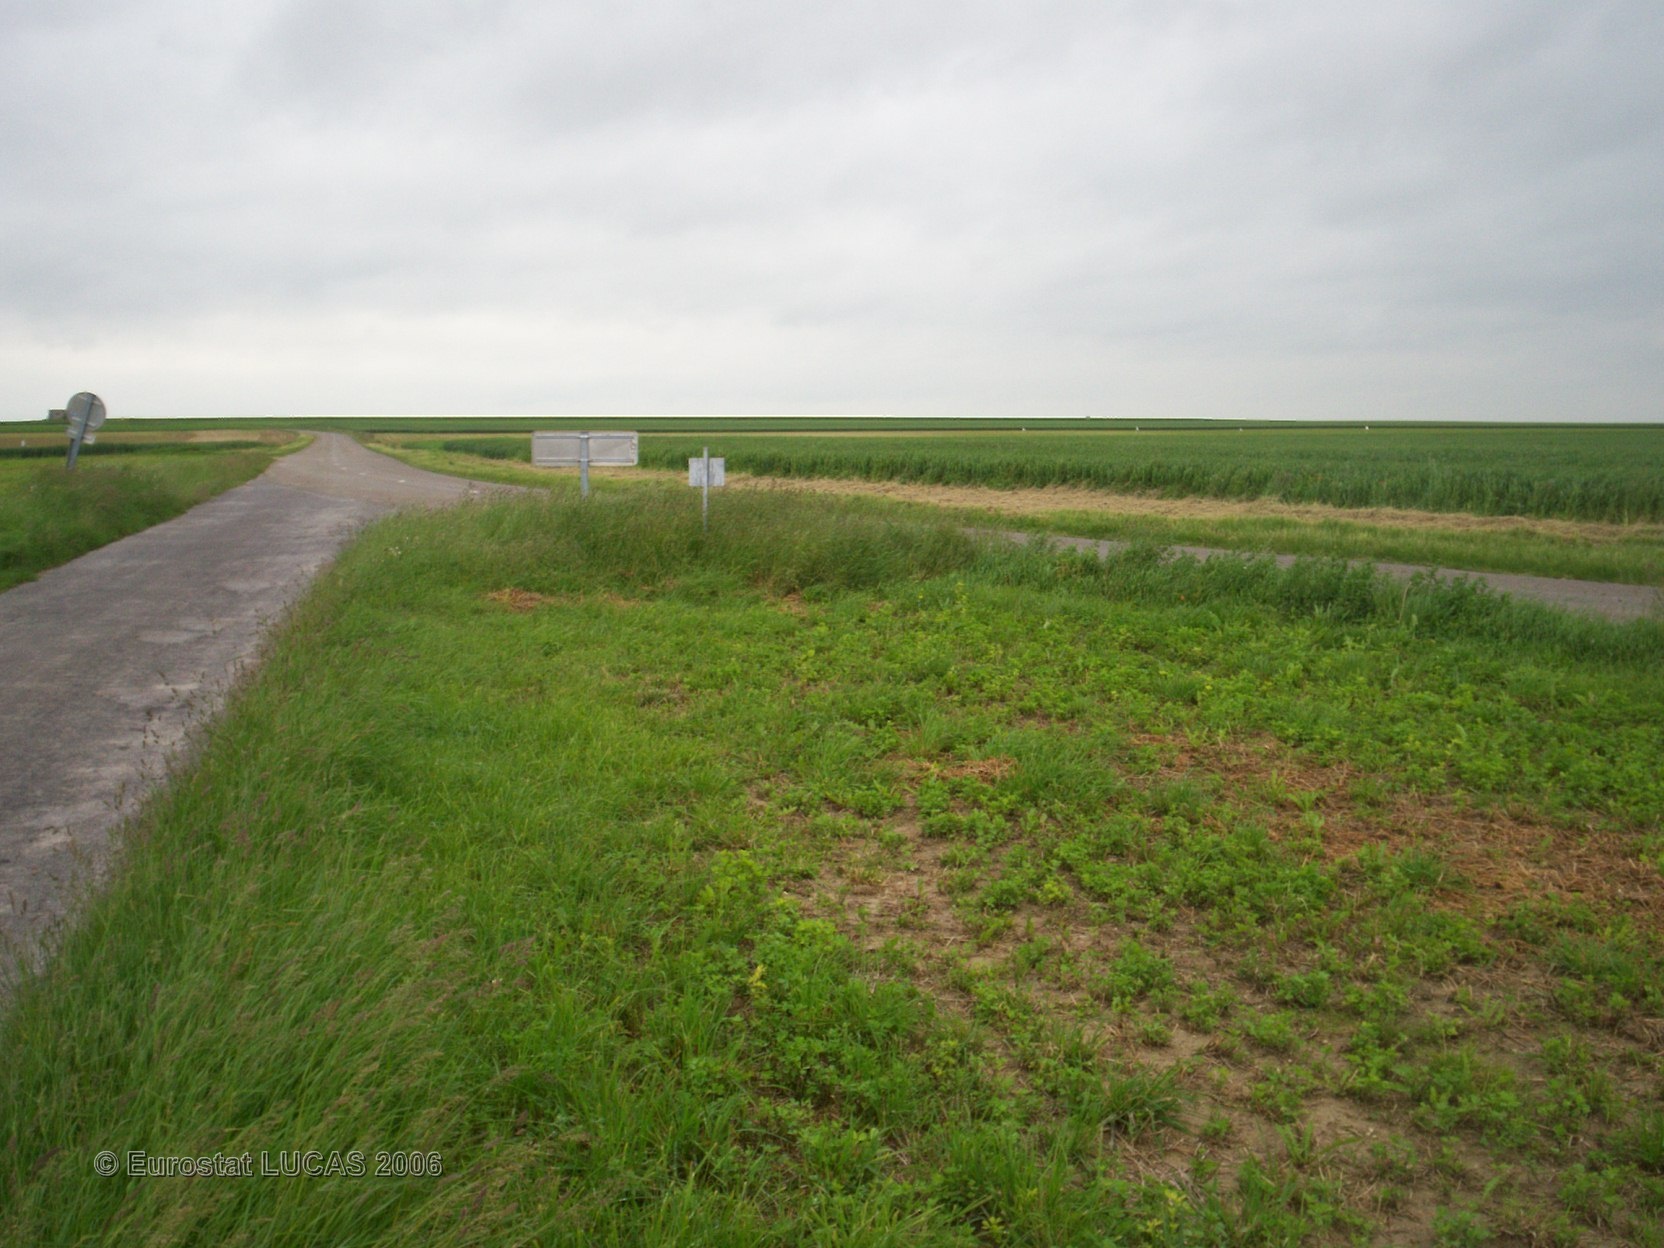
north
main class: Cropland
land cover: Lucerne
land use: Agriculture (excluding fallow land and kitchen gardens)
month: May
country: FR
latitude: 49.3074
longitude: 4.3983
